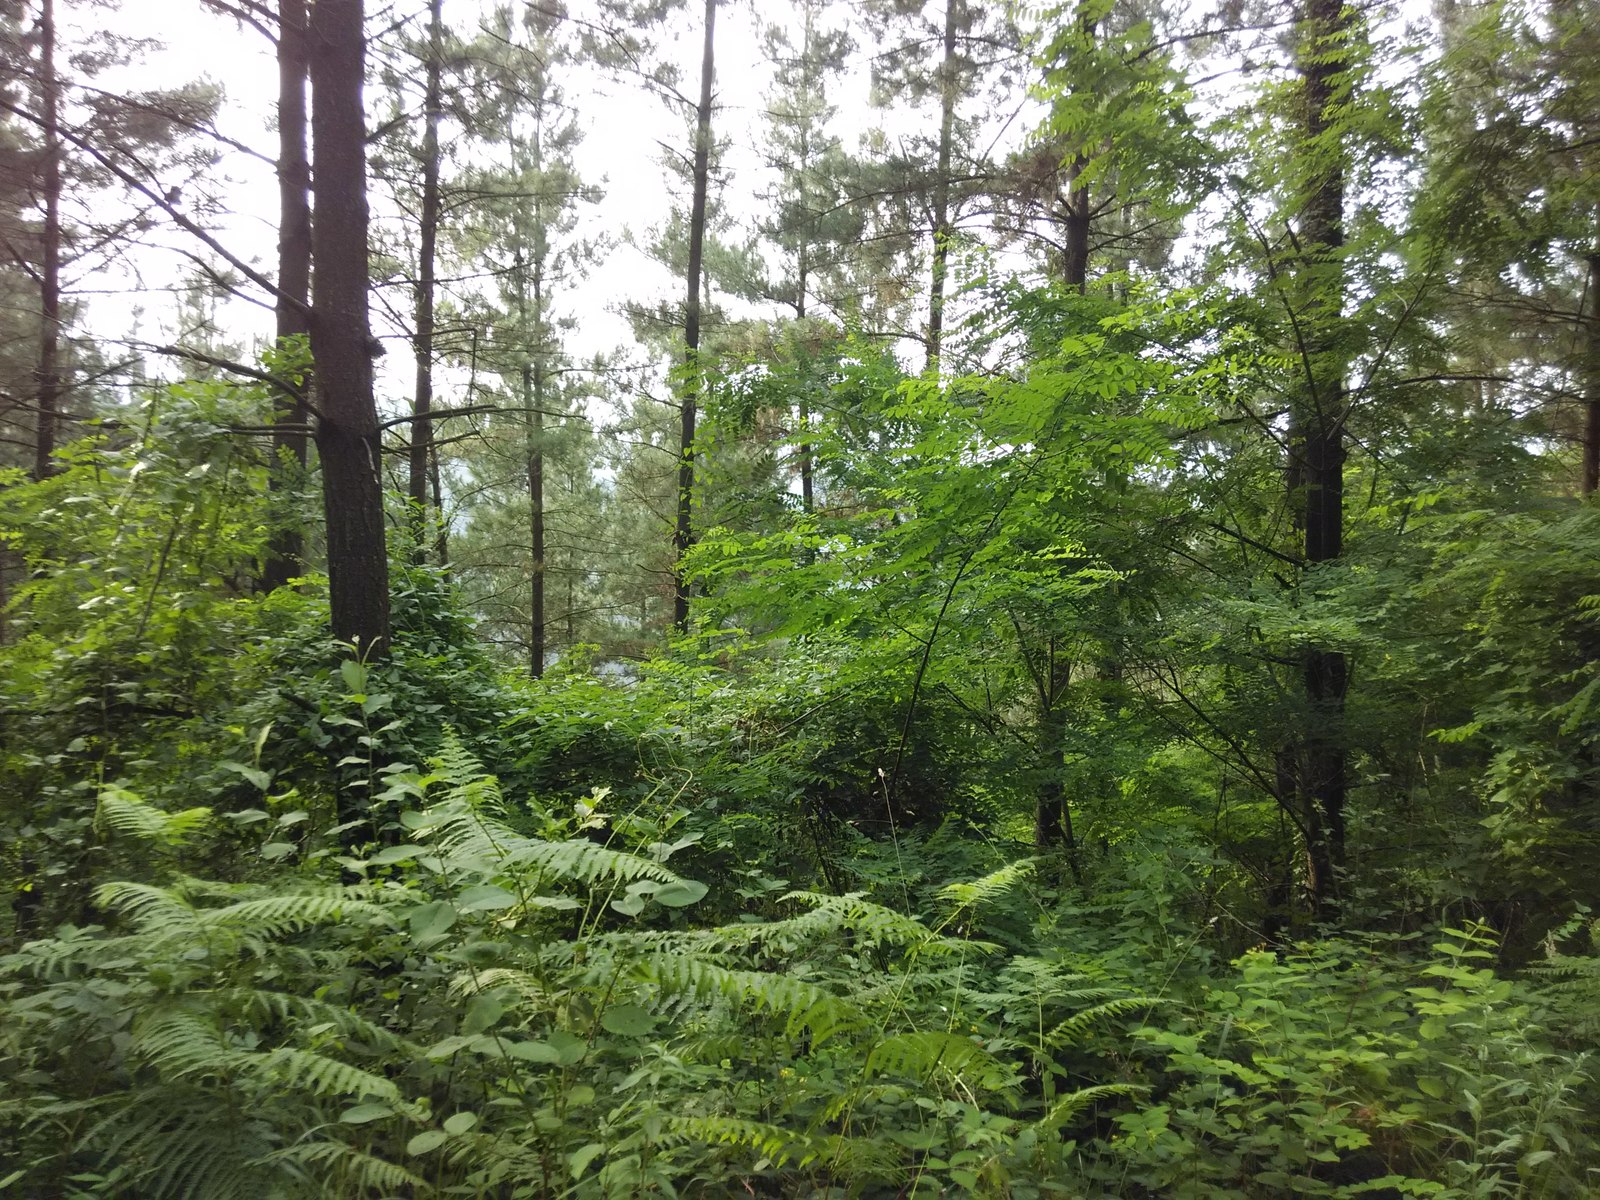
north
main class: Woodland
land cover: Pine dominated coniferous woodland
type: exotic forest
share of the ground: > 75 %
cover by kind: coniferous forest trees 100 %
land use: Forestry
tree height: > 5 m
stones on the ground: < 10 %
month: July
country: ES
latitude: 43.0371
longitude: -2.2607
